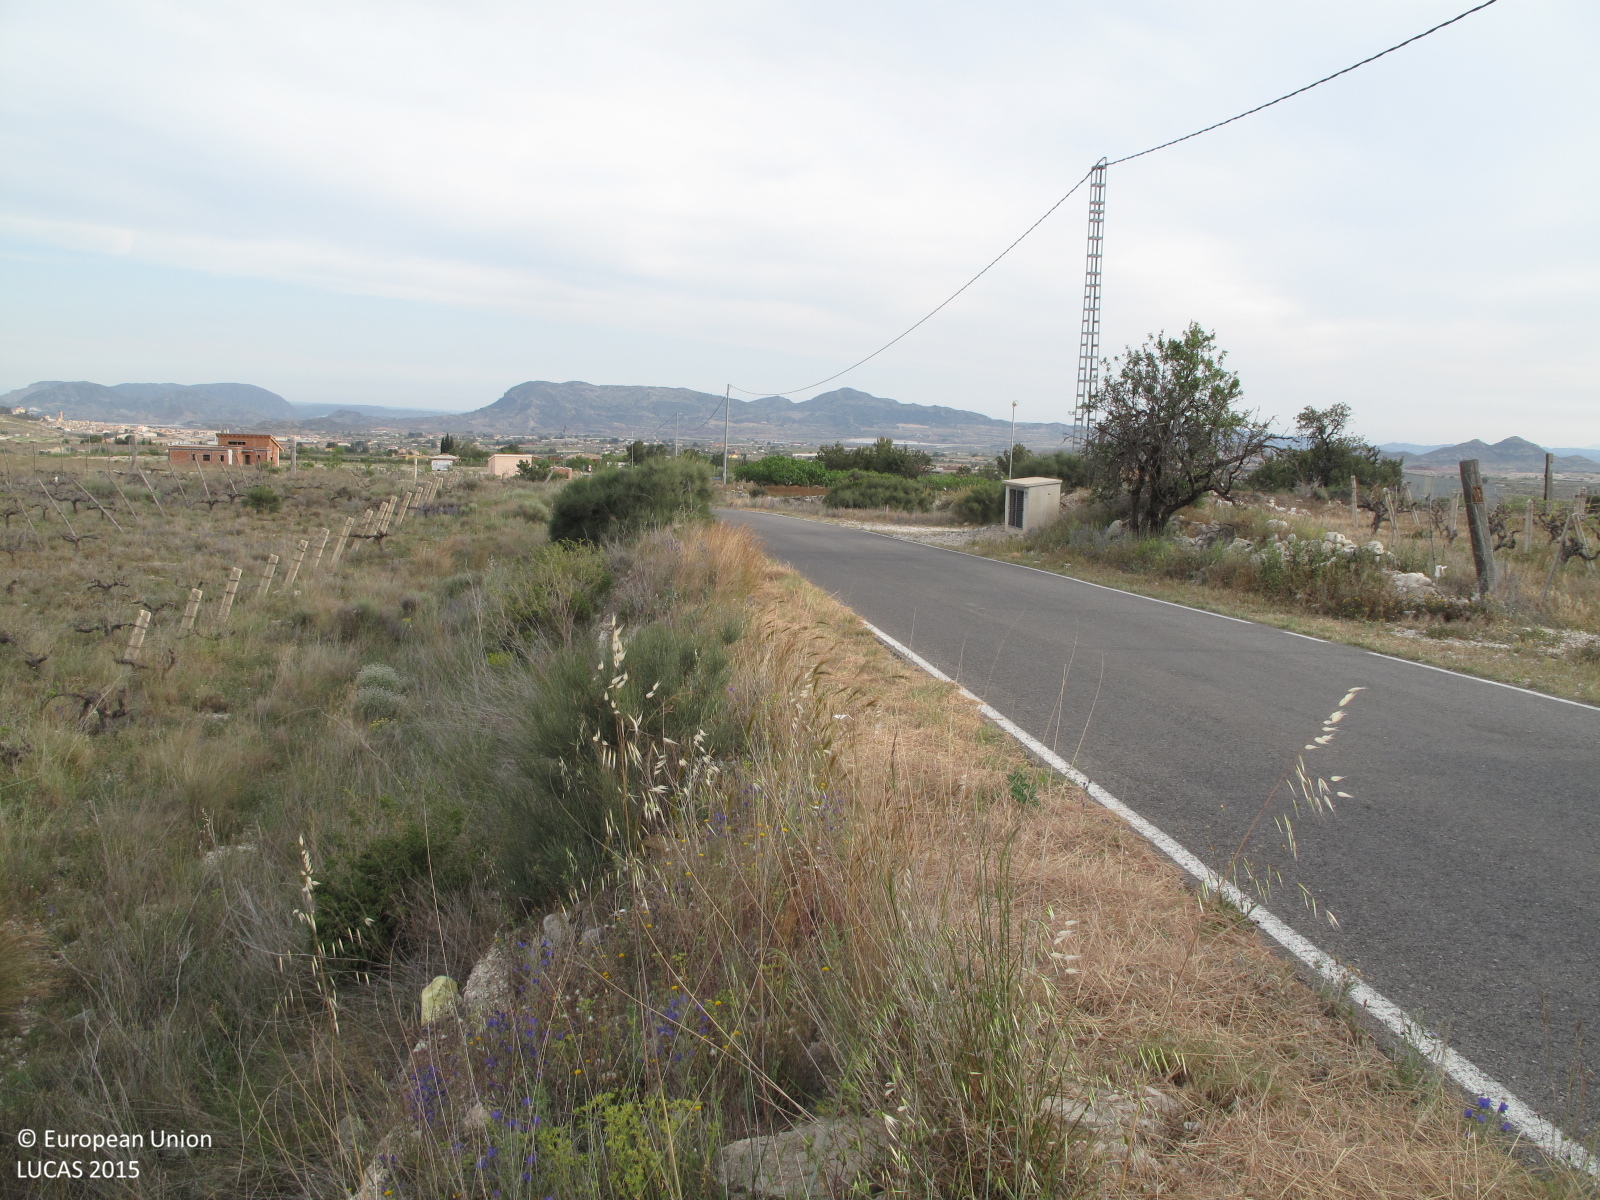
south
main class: Grassland
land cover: Spontaneously vegetated surfaces
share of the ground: > 75 %
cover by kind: herbaceous plants 80 %, unconsolidated bare surface 20 %
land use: Abandoned areas
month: April
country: ES
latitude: 38.4625
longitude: -0.6571
